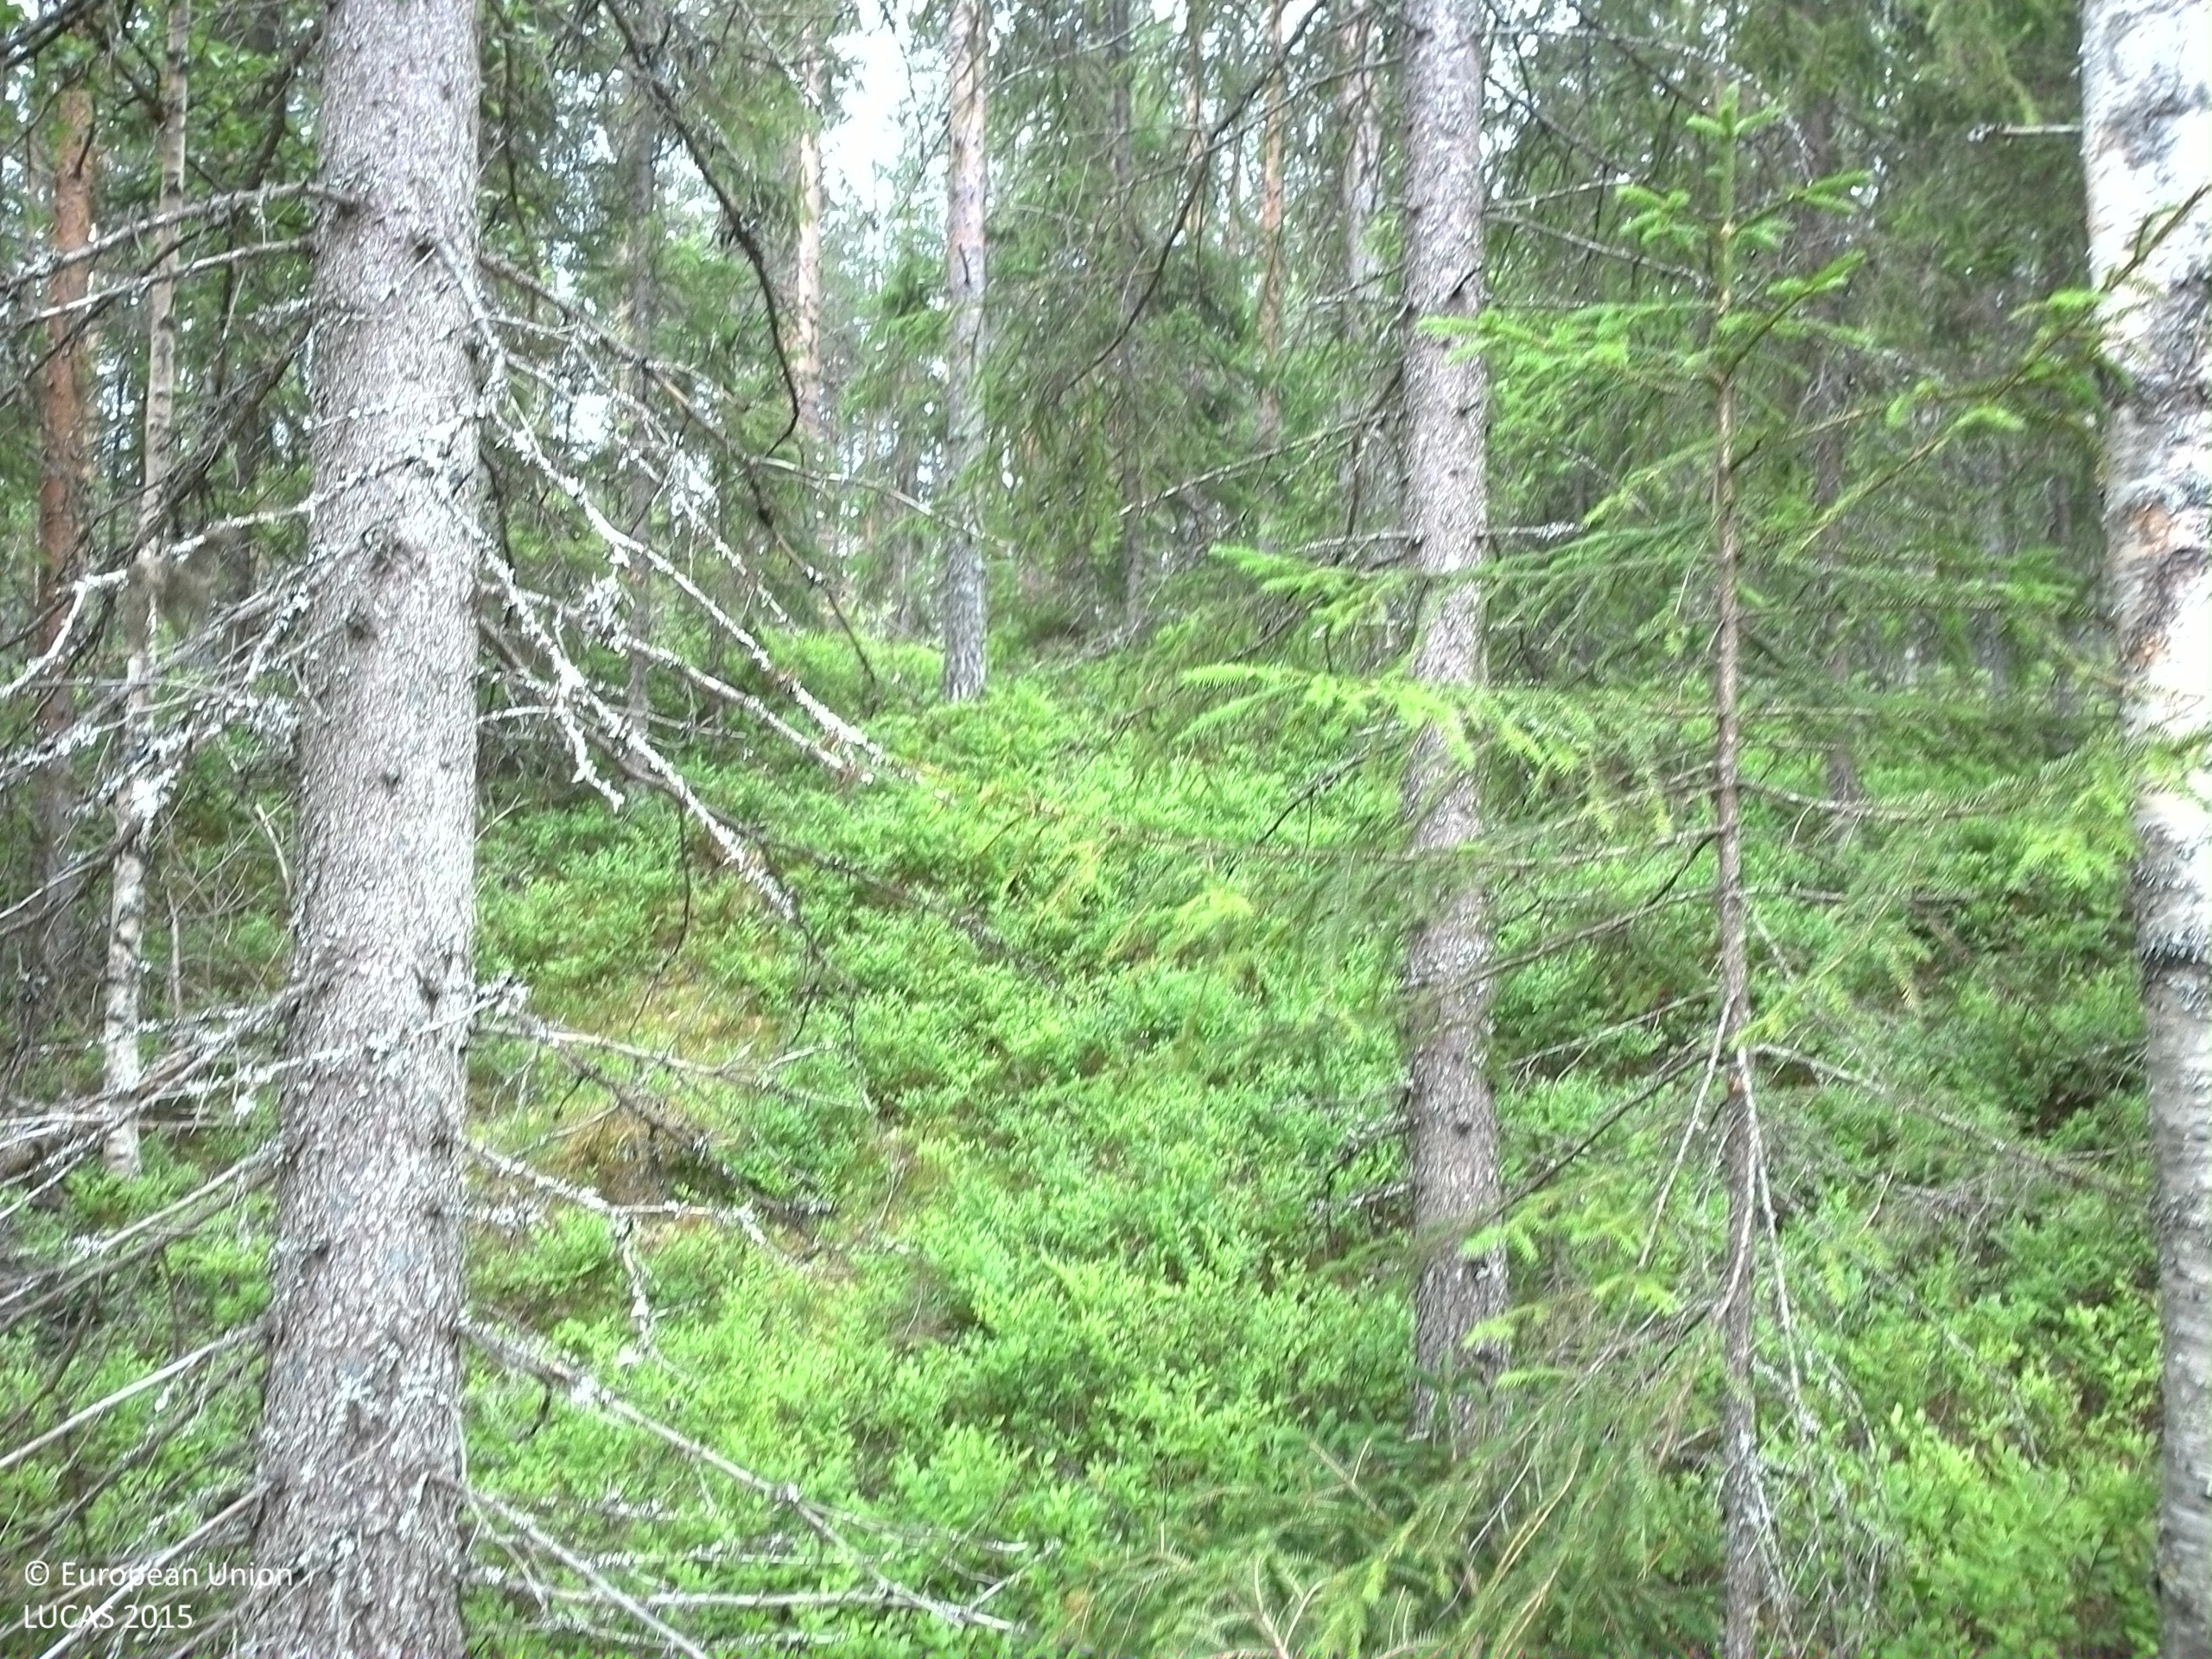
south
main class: Woodland
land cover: Spruce dominated mixed woodland
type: boreal forest
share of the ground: 50 - 75 %
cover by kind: coniferous forest trees 50 %, broadleaved forest trees 20 %, shrubs 20 %, lichens and mosses 10 %
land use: Forestry
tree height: > 5 m
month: July
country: SE
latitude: 63.6042
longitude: 17.4934
